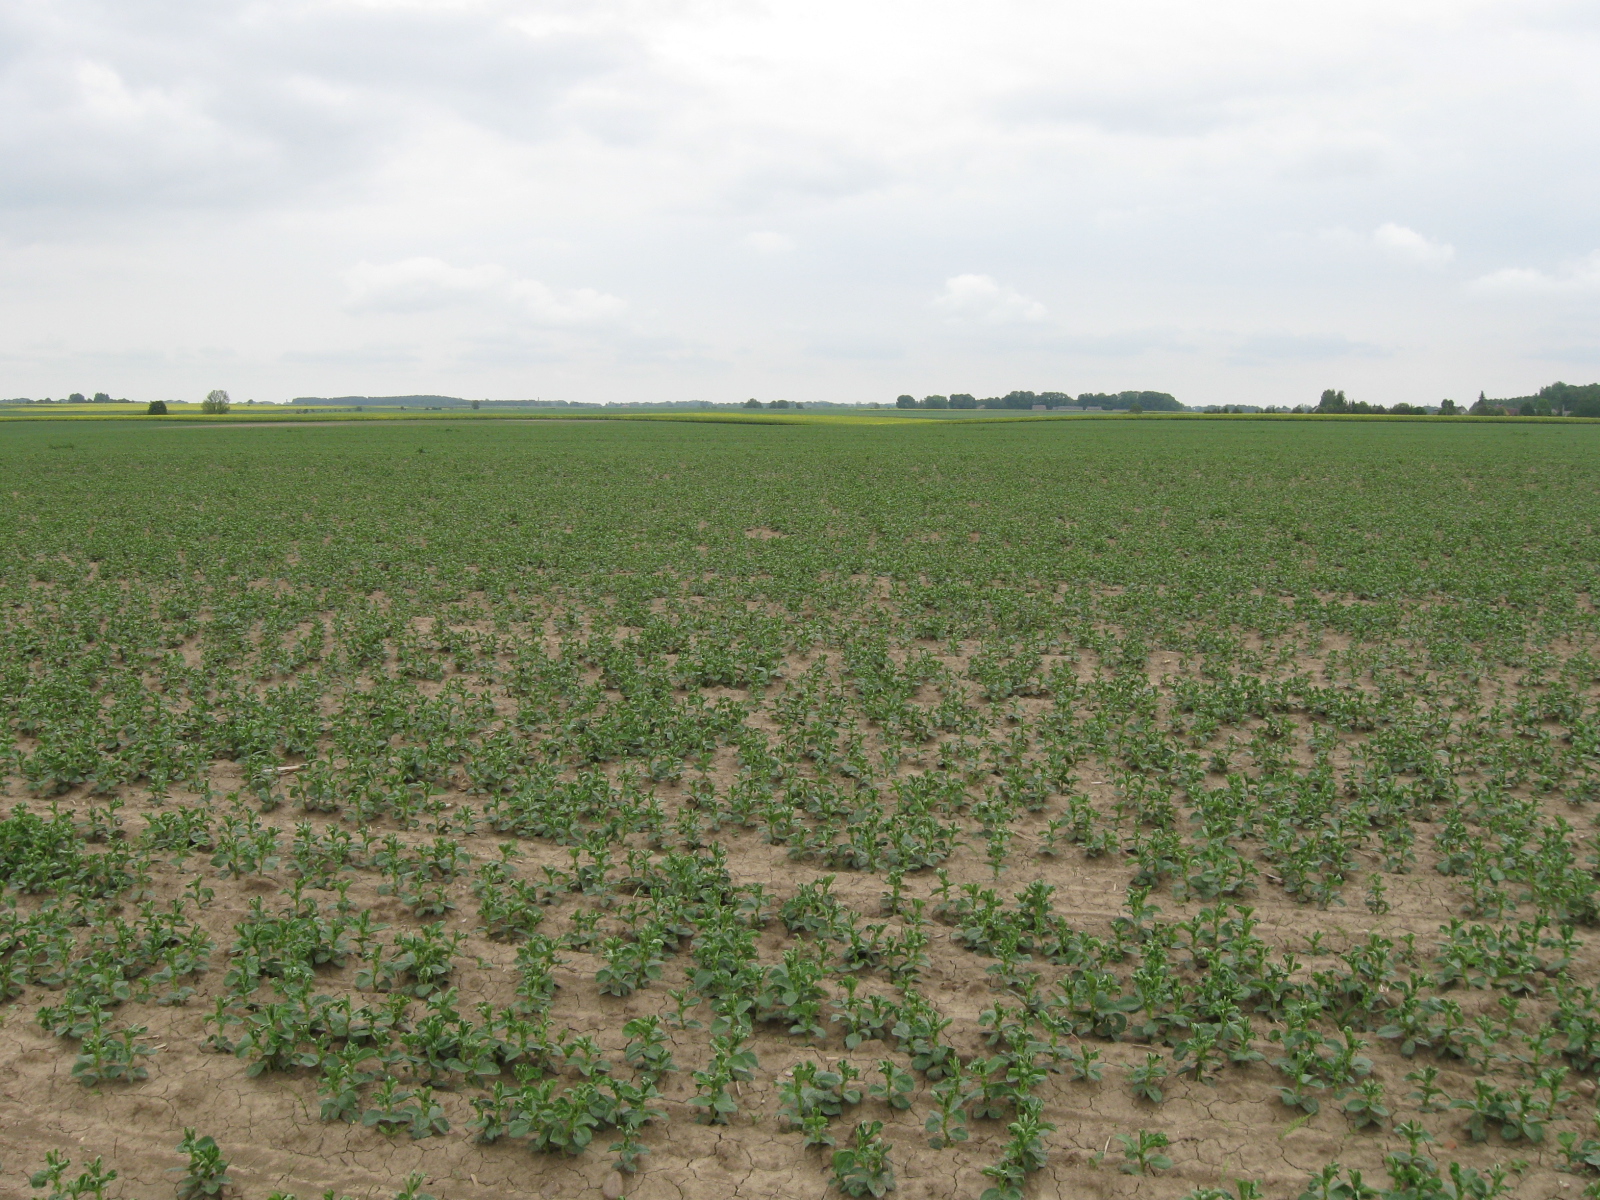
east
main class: Cropland
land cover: Dry pulses
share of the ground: 50 - 75 %
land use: Agriculture (excluding fallow land and kitchen gardens)
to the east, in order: Dry pulses
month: May
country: LT
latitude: 54.6446
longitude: 22.8539
